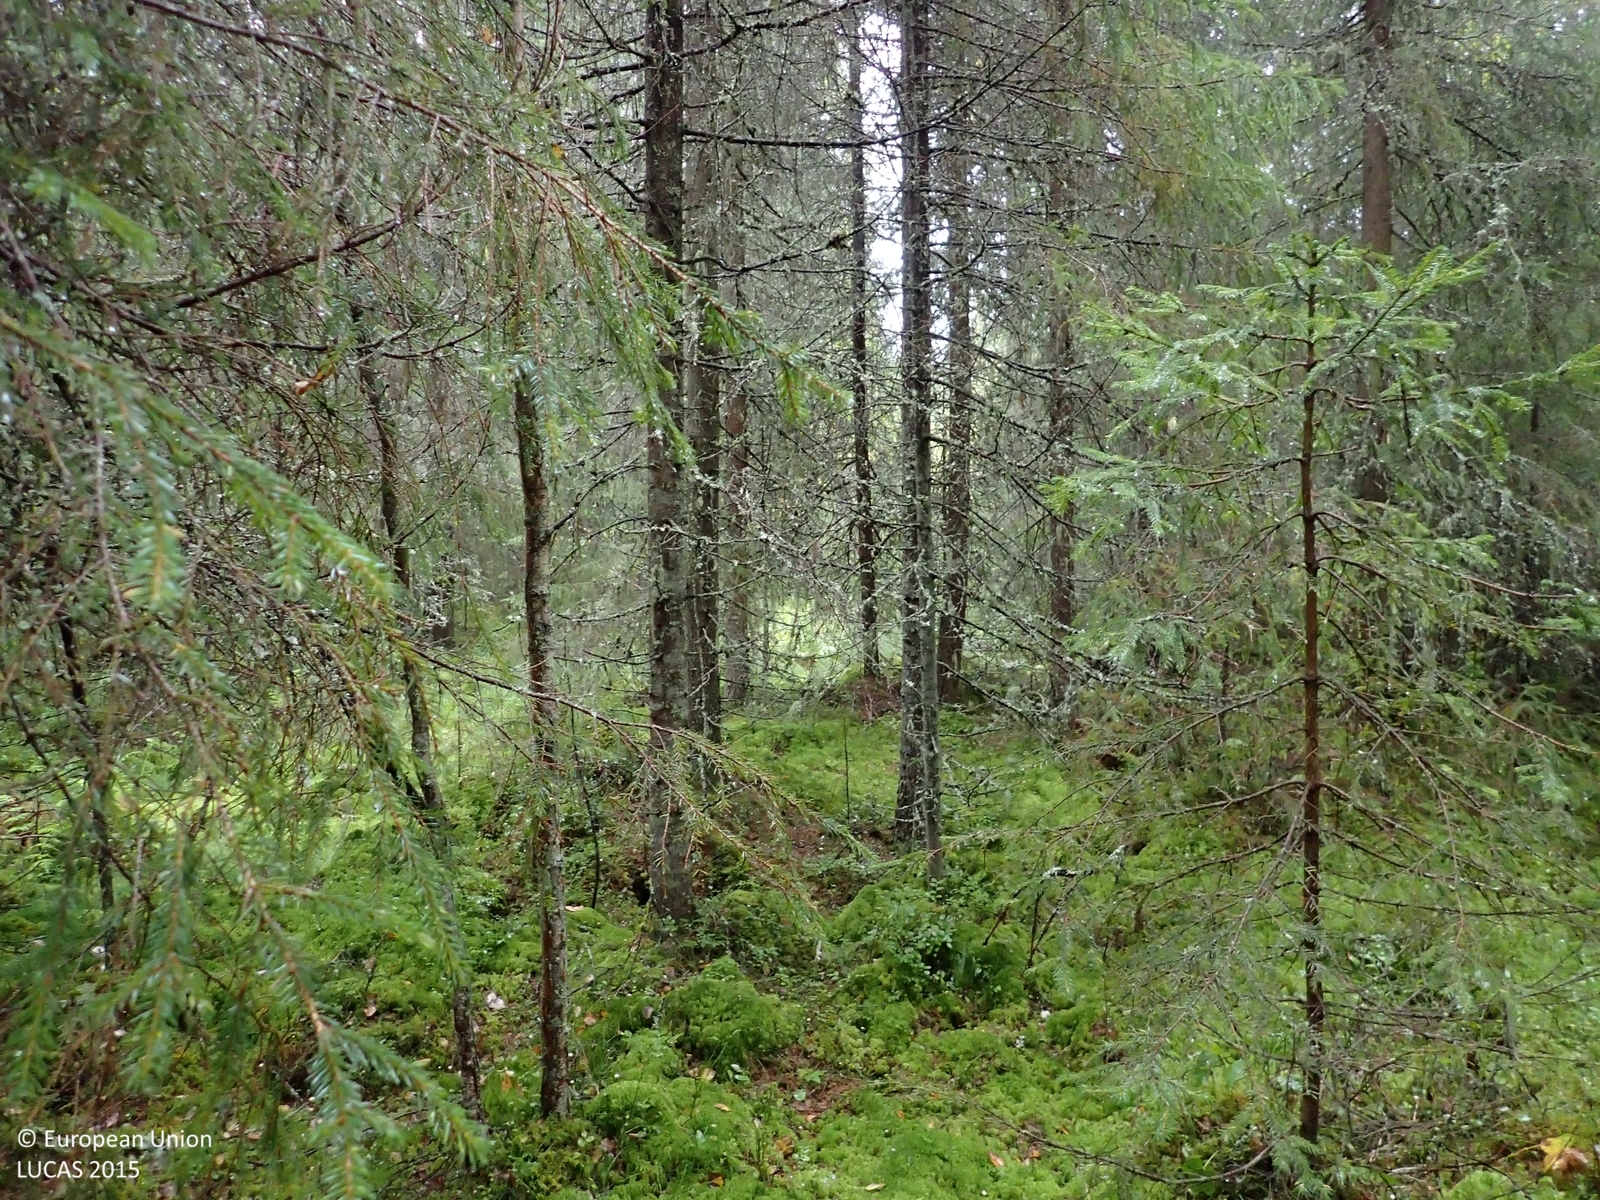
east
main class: Woodland
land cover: Spruce dominated coniferous woodland
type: boreal forest
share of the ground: > 75 %
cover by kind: coniferous forest trees 70 %, broadleaved forest trees 10 %, shrubs 10 %, lichens and mosses 10 %
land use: Forestry
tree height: > 5 m
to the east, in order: Spruce dominated coniferous woodland; Ditches and canals; Spruce dominated coniferous woodland; Pine dominated mixed woodland; Ditches and canals; Pine dominated mixed woodland; Ditches and canals; Pine dominated mixed woodland; Other mixed woodland
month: September
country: FI
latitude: 63.1523
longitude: 26.1782
